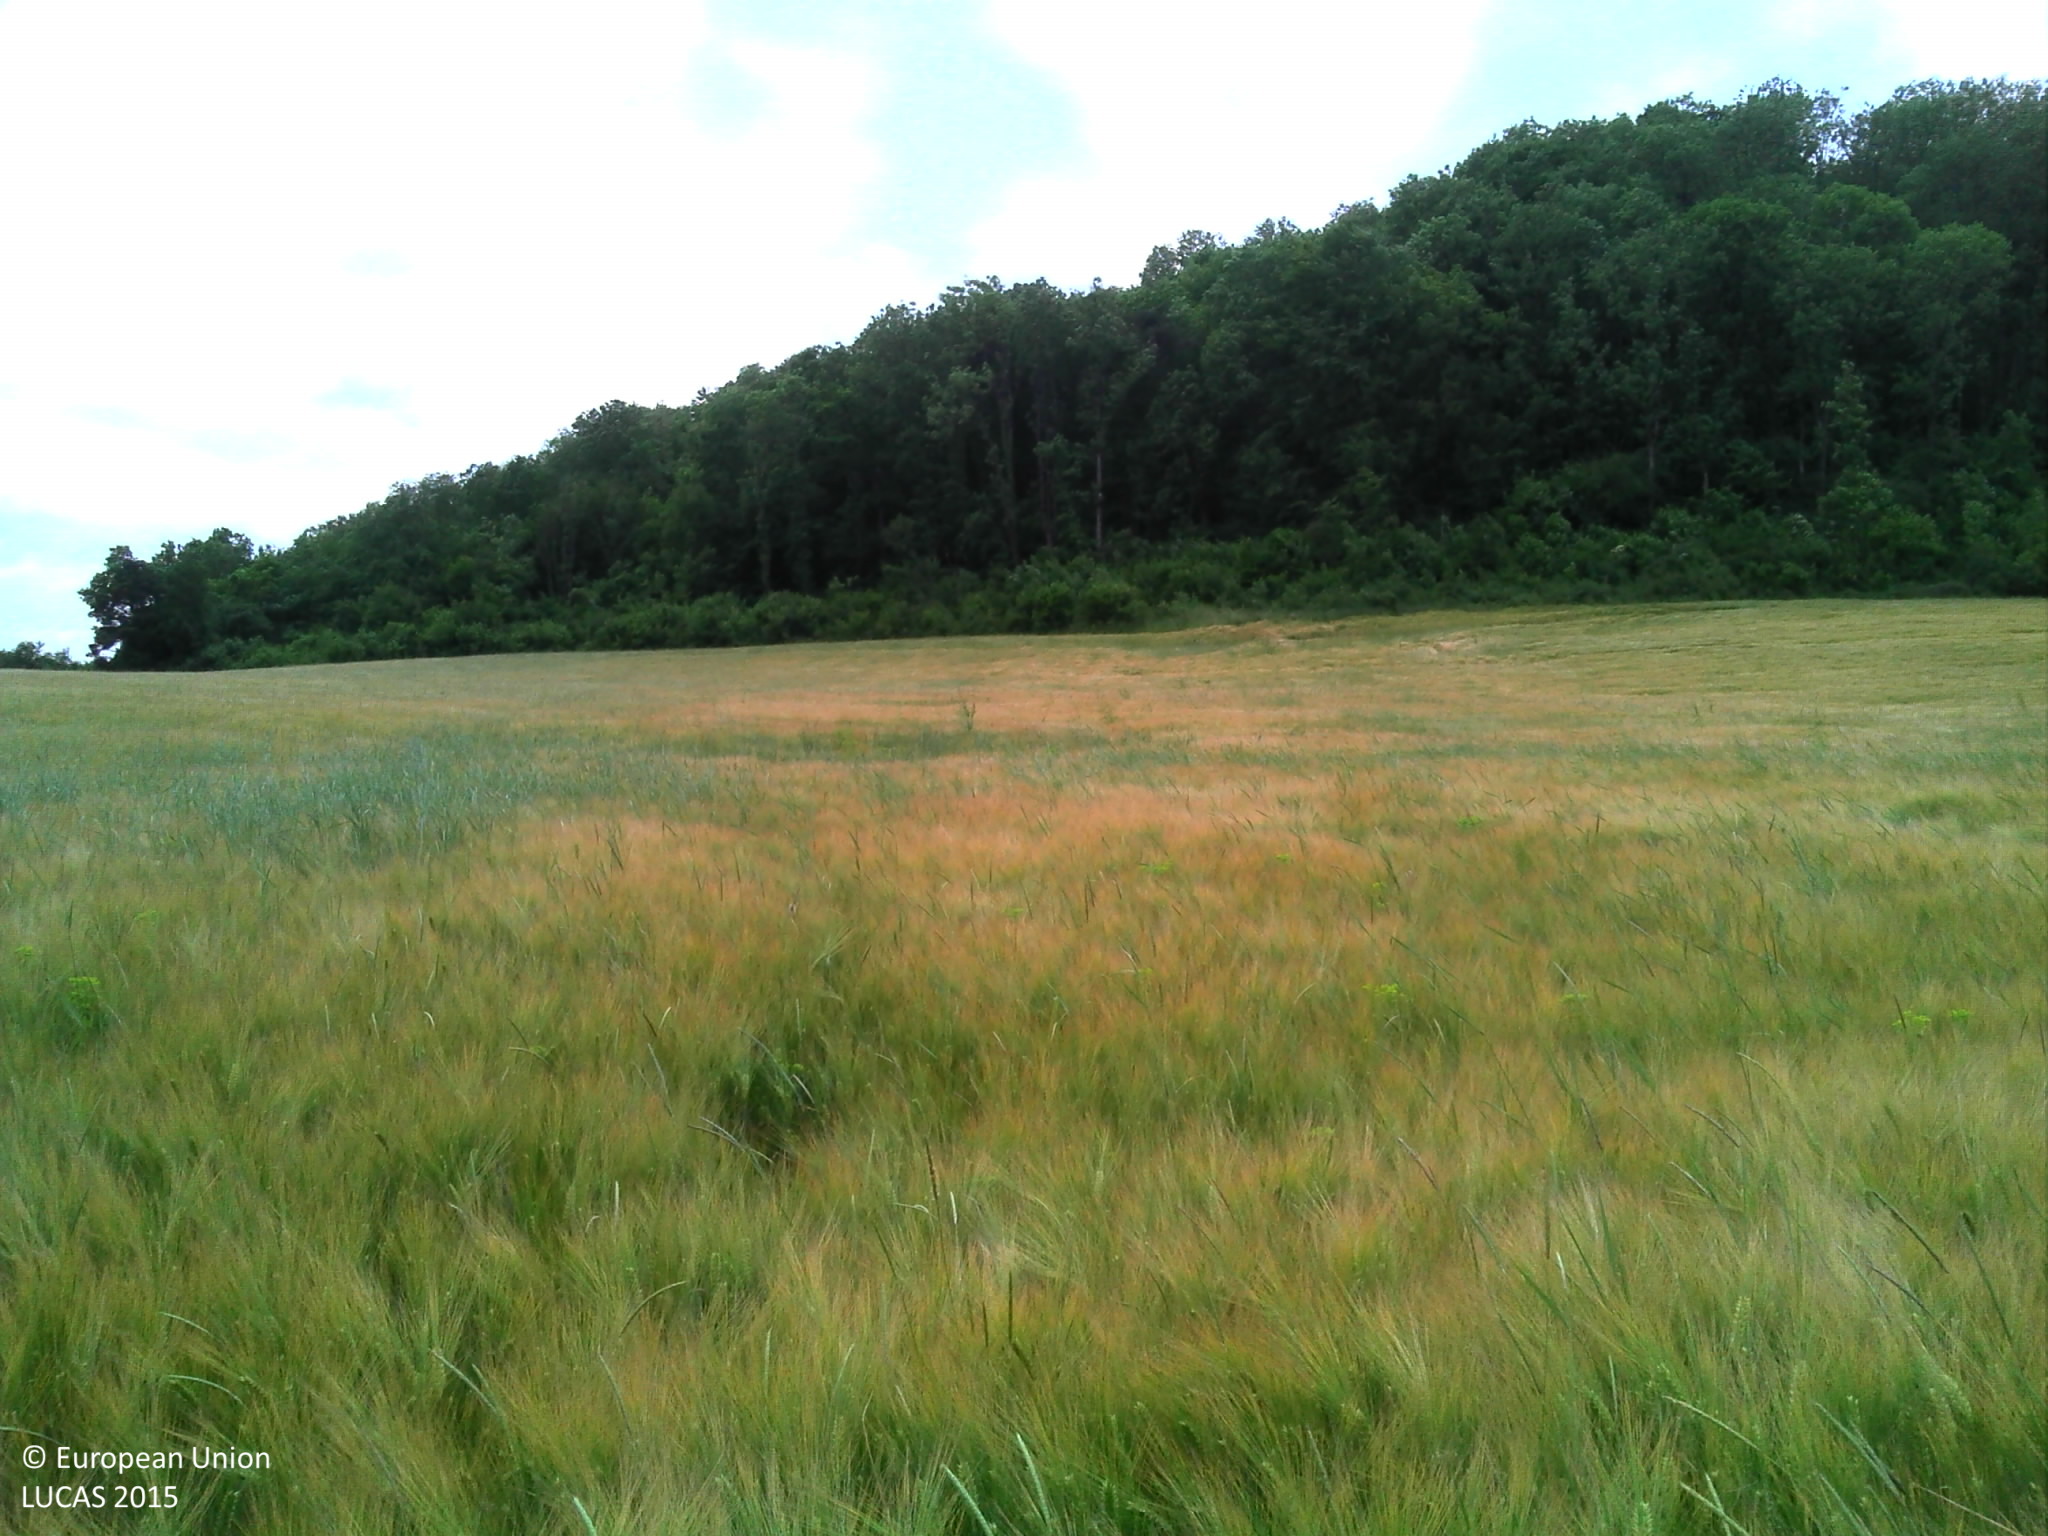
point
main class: Cropland
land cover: Barley
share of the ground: > 75 %
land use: Agriculture (excluding fallow land and kitchen gardens)
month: June
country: FR
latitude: 48.5200
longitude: 6.2499
